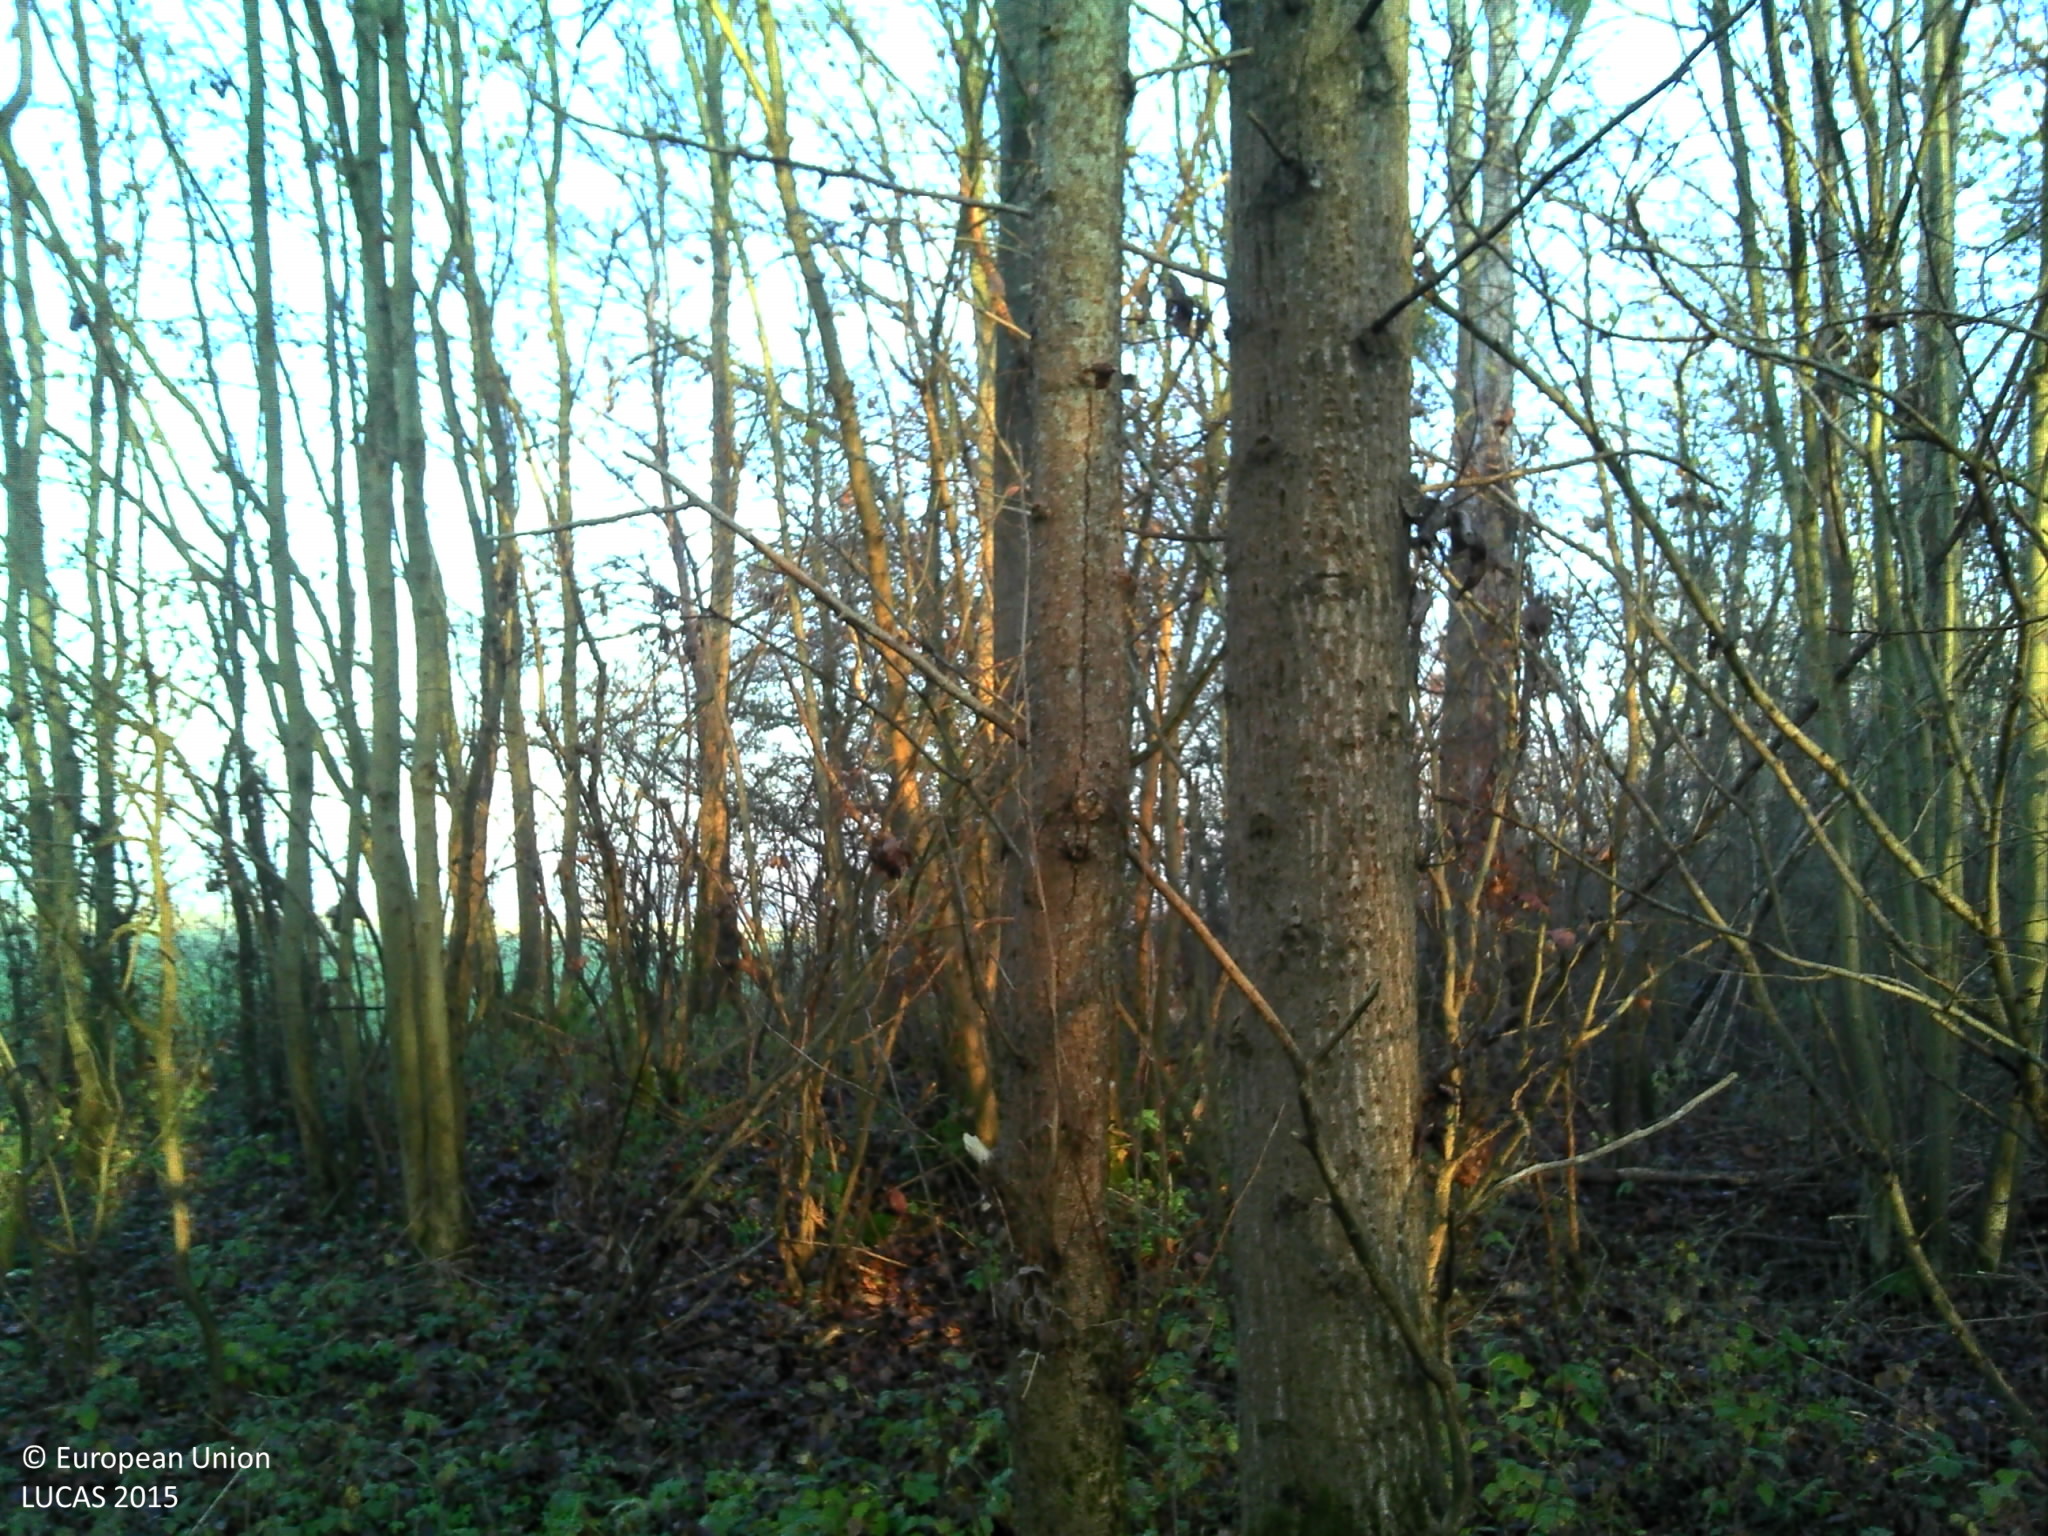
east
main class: Woodland
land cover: Broadleaved woodland
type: floodplain forest
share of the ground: > 75 %
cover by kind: broadleaved forest trees 90 %, herbaceous plants 10 %
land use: Semi-natural and natural areas not in use
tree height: > 5 m
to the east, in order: Broadleaved woodland; Fences; Grassland without tree/shrub cover; Broadleaved woodland; Grassland without tree/shrub cover
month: December
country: FR
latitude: 46.2621
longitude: 4.8258
